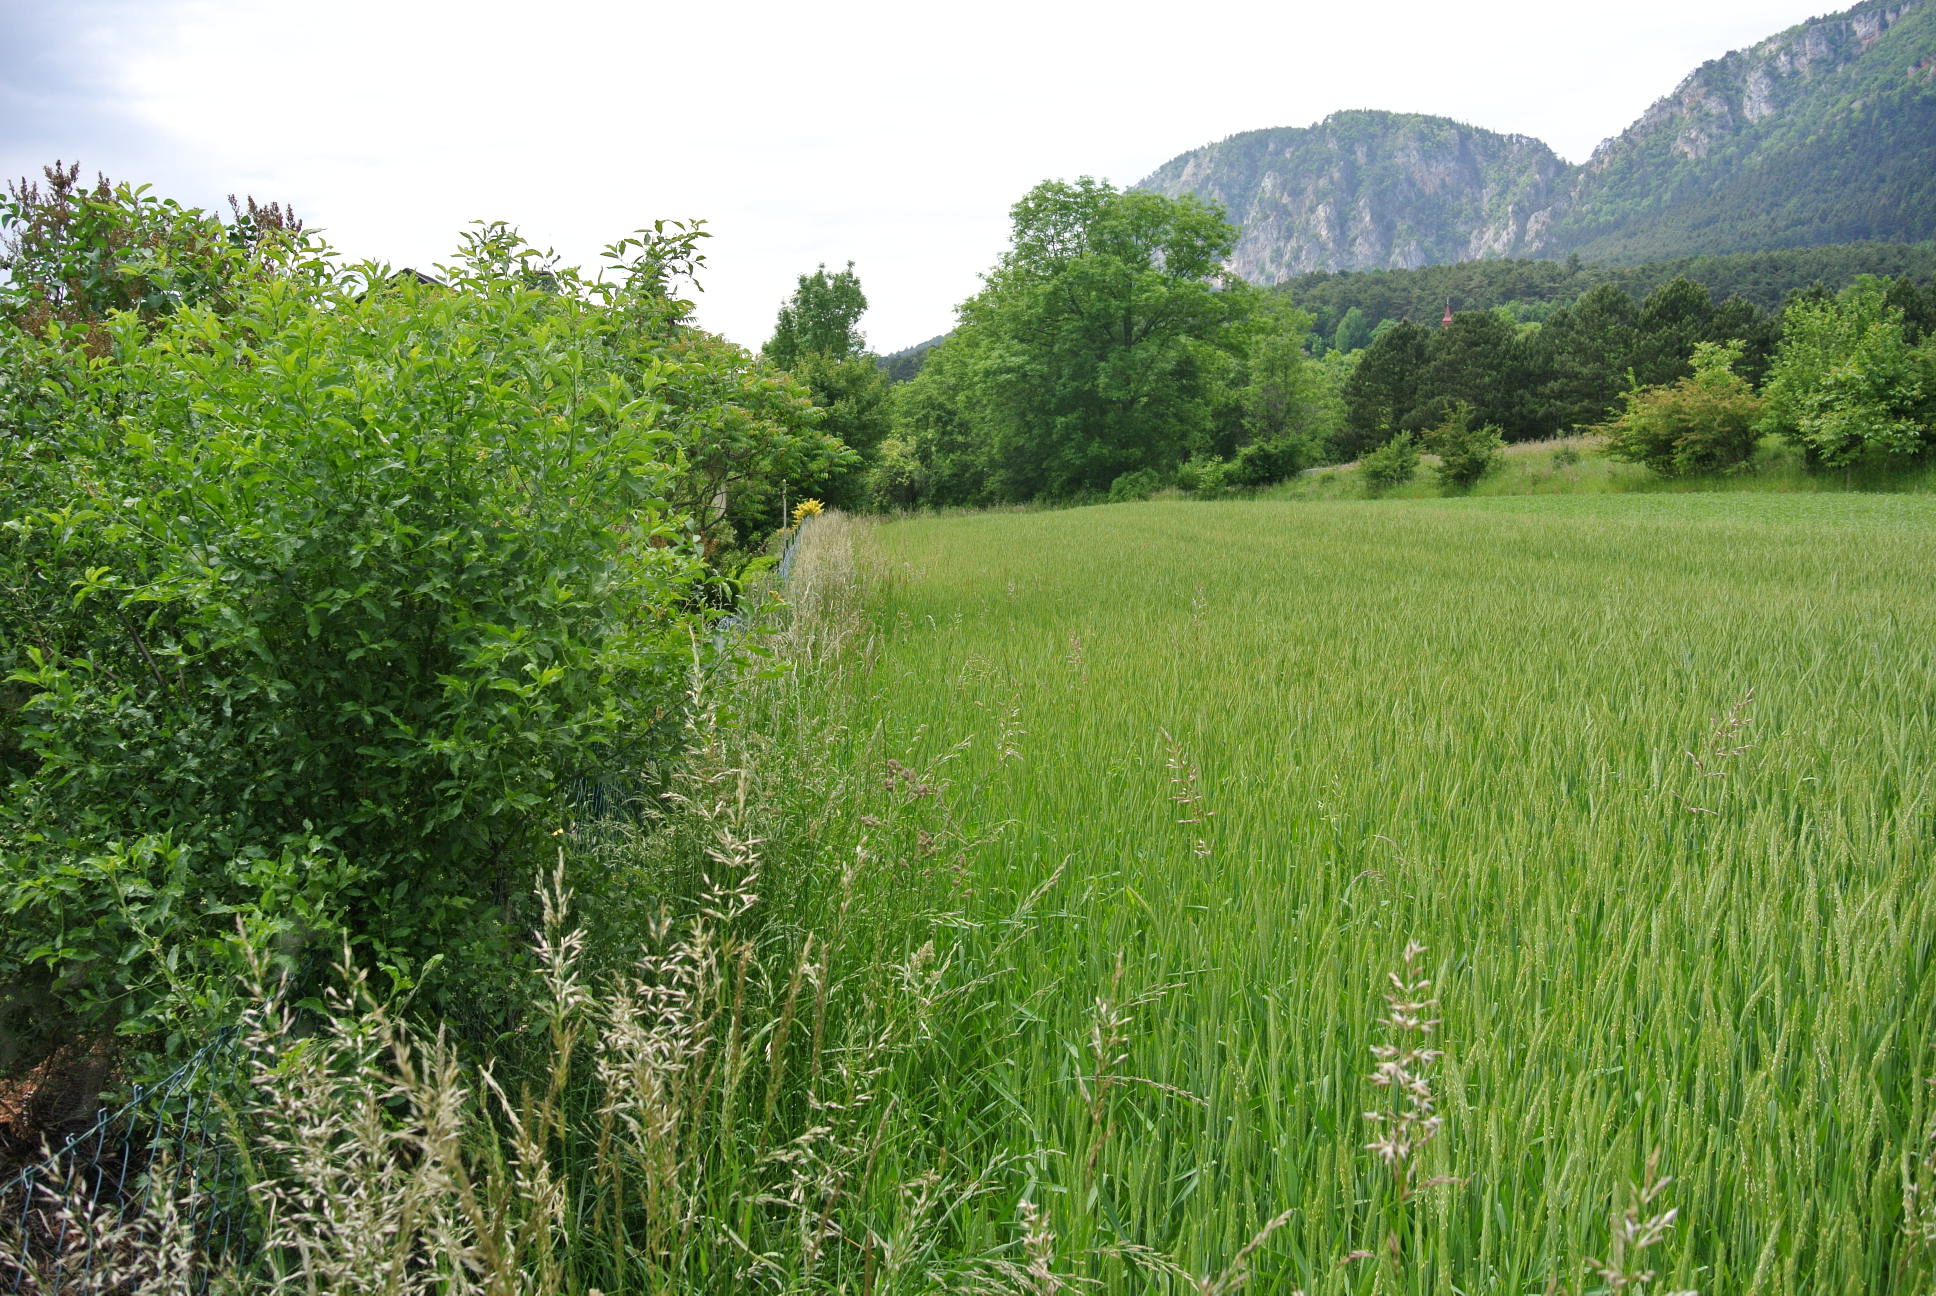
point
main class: Cropland
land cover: Rye
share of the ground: > 75 %
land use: Agriculture (excluding fallow land and kitchen gardens)
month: May
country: AT
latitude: 47.8226
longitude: 16.0538
